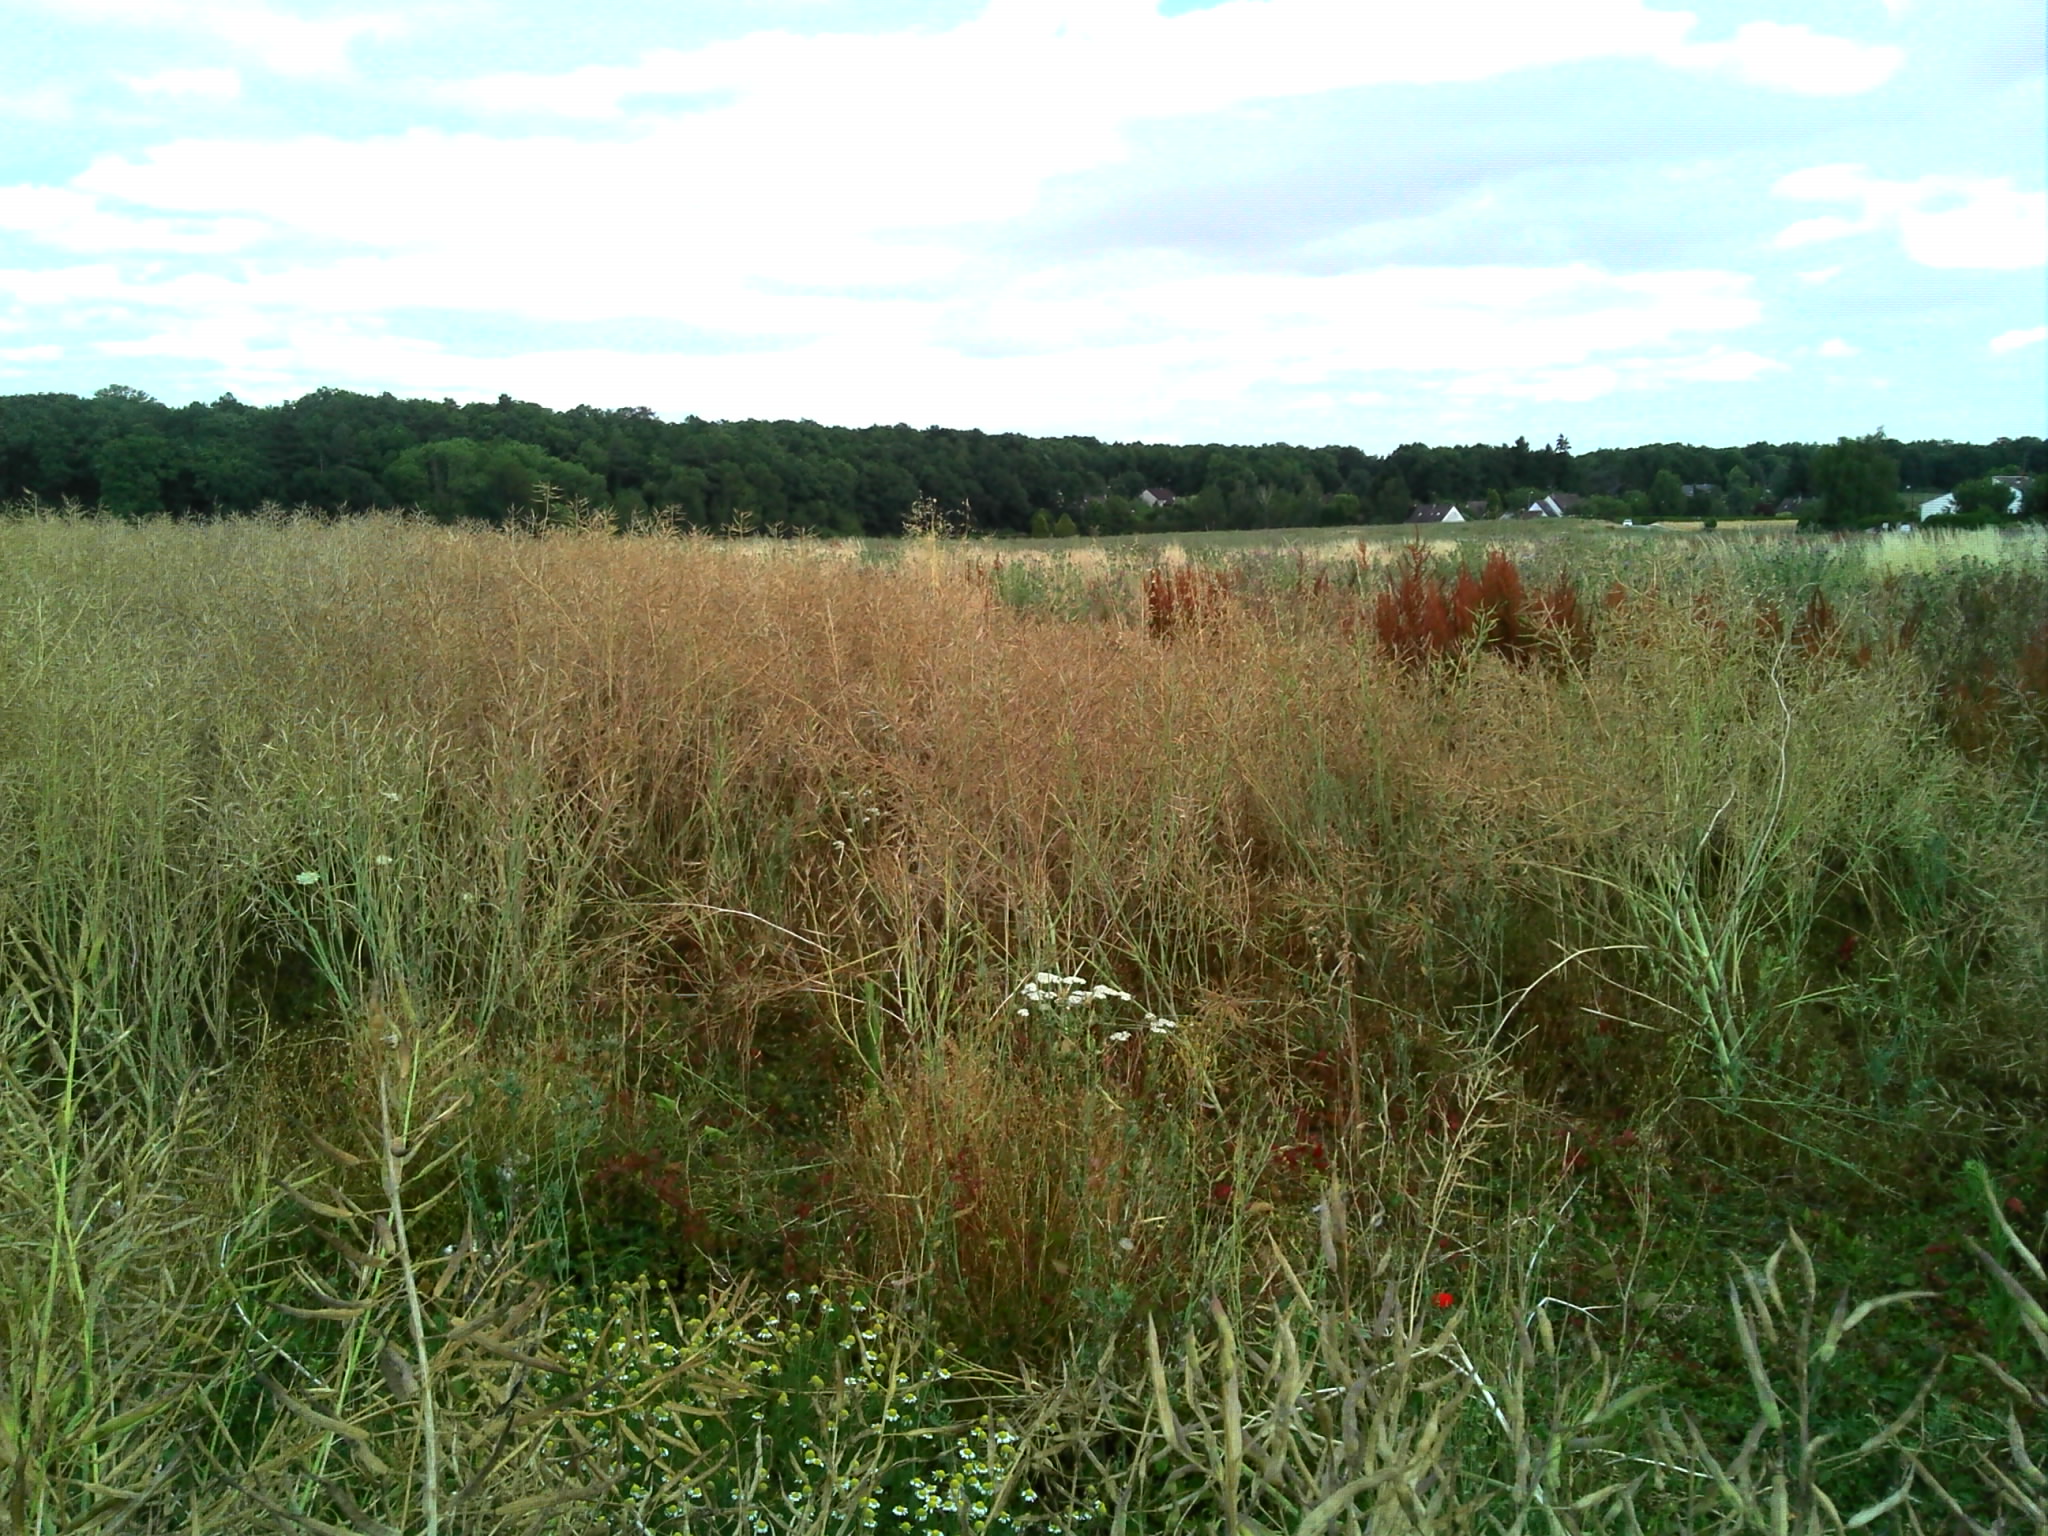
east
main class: Cropland
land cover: Rape and turnip rape
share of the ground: > 75 %
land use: Agriculture (excluding fallow land and kitchen gardens)
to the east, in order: Rape and turnip rape; Spontaneously vegetated surfaces
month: July
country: FR
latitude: 48.9482
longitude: 1.0900
